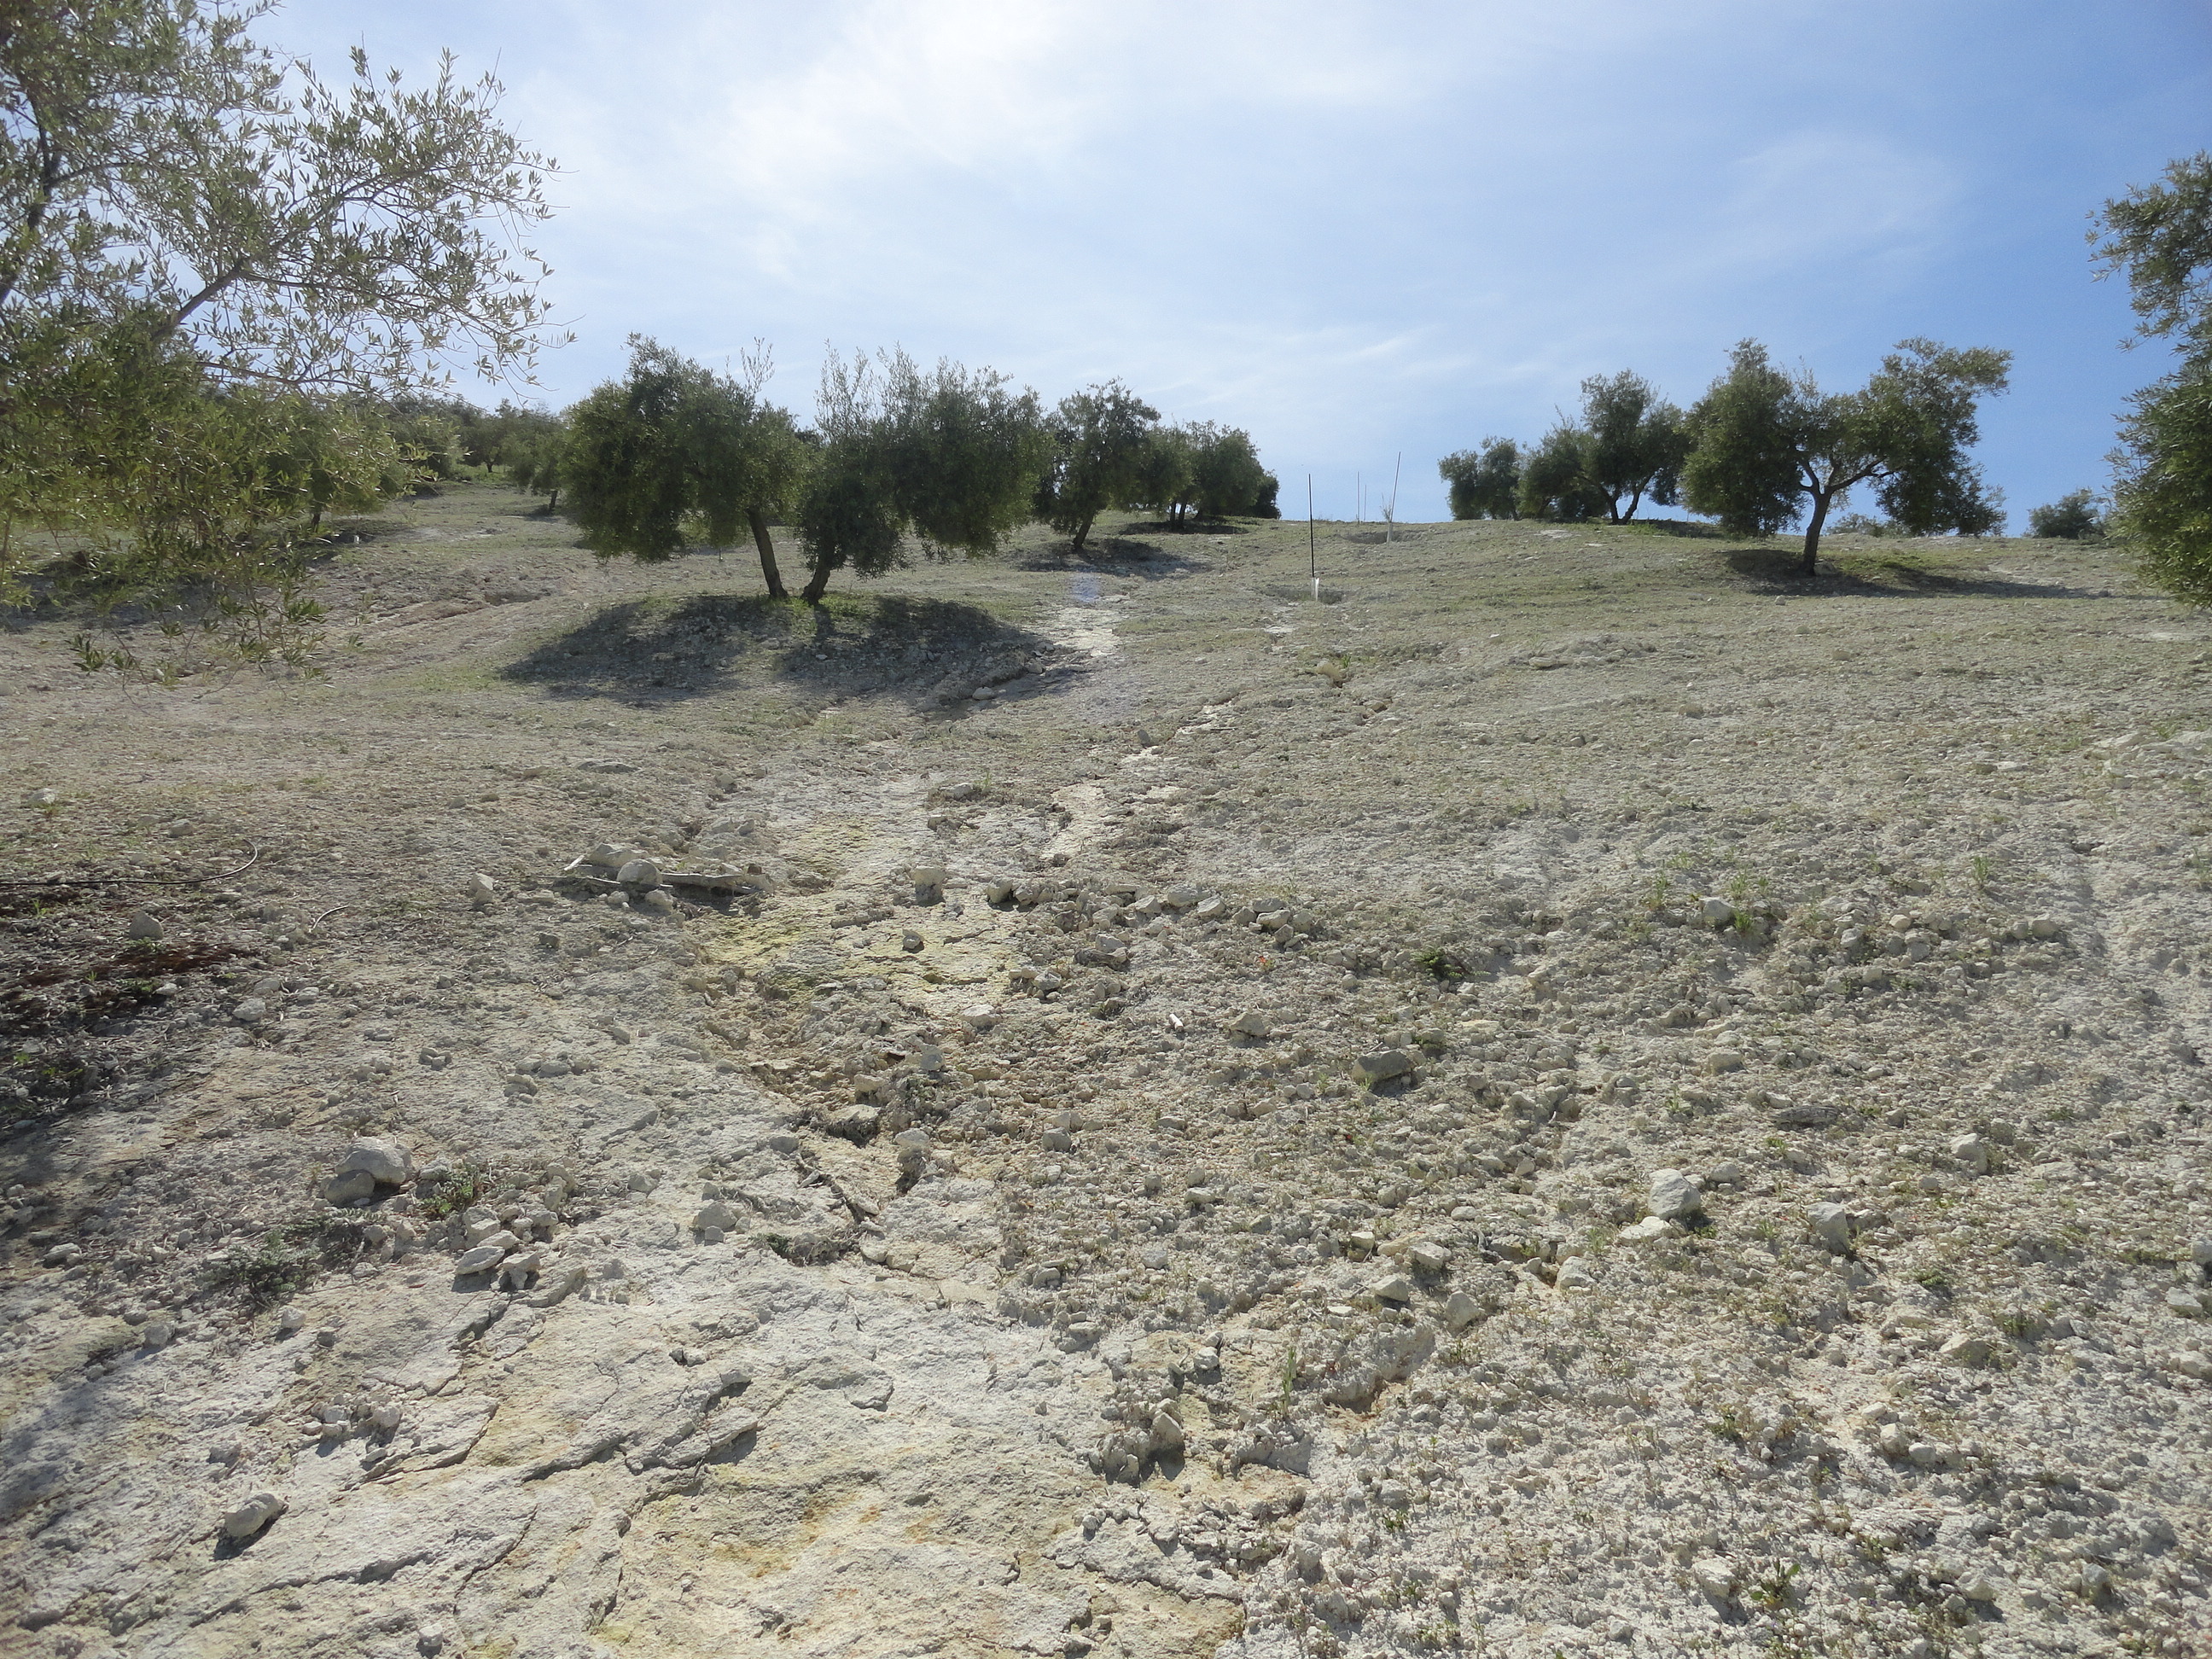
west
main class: Cropland
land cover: Olive groves
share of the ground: 25 - 50 %
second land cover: Other bare soil
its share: > 75 %
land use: Agriculture (excluding fallow land and kitchen gardens)
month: April
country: ES
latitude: 37.6477
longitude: -4.4570
